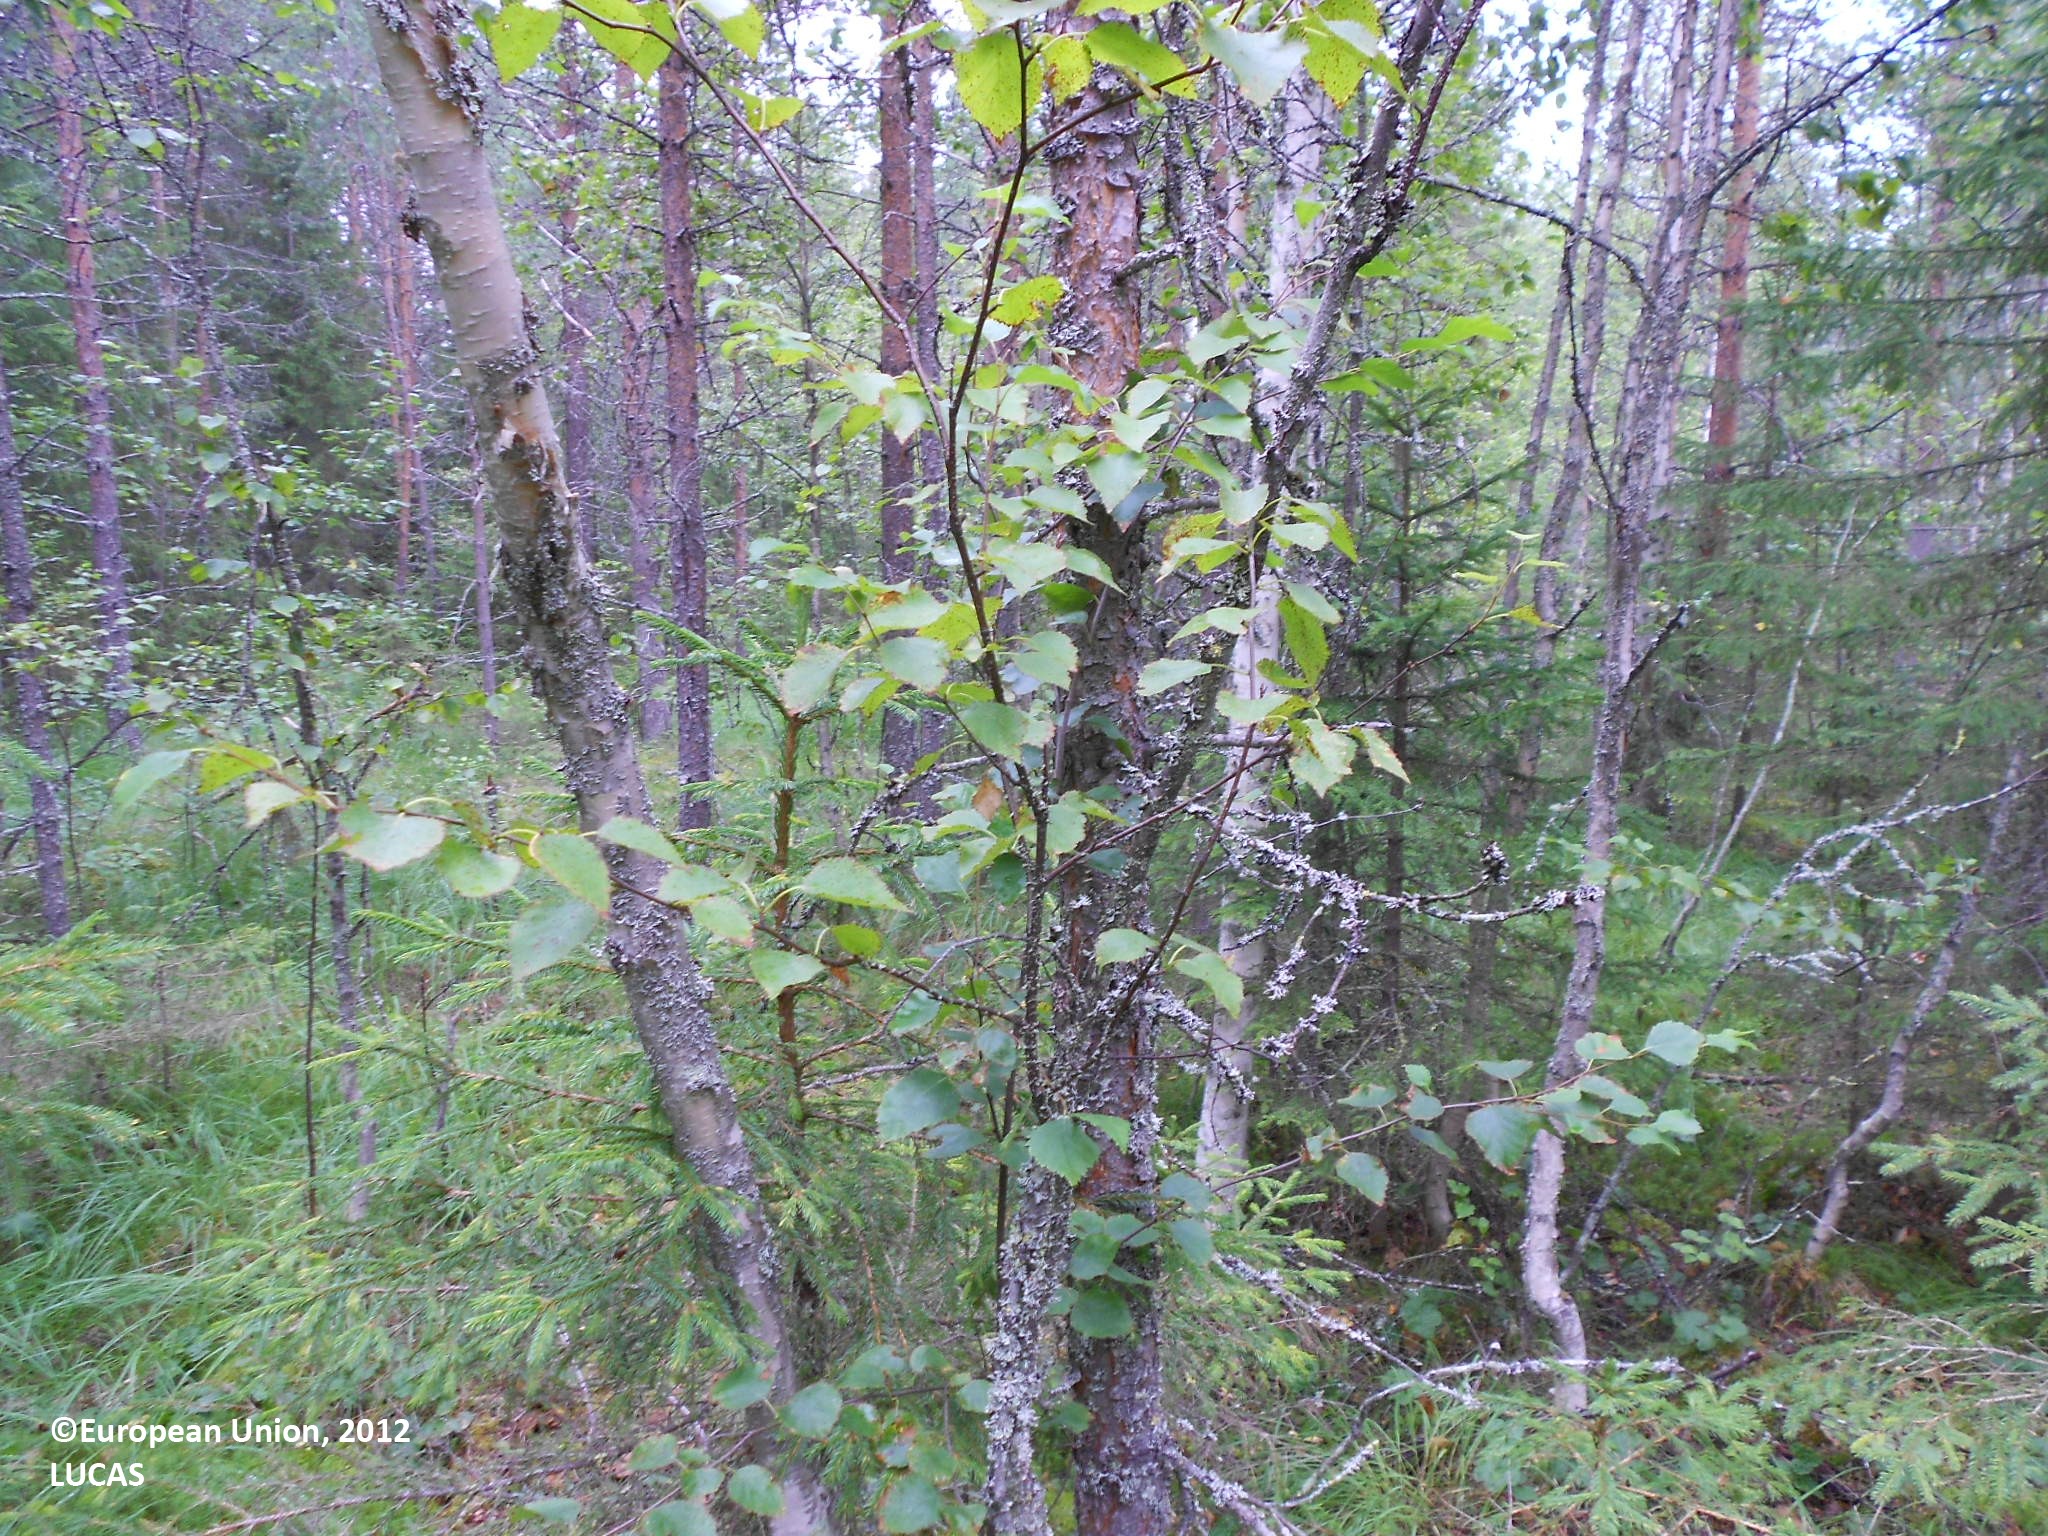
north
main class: Woodland
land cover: Pine dominated coniferous woodland
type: boreal forest
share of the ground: 50 - 75 %
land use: Forestry
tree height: > 5 m
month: August
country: FI
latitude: 63.4263
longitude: 28.9402
